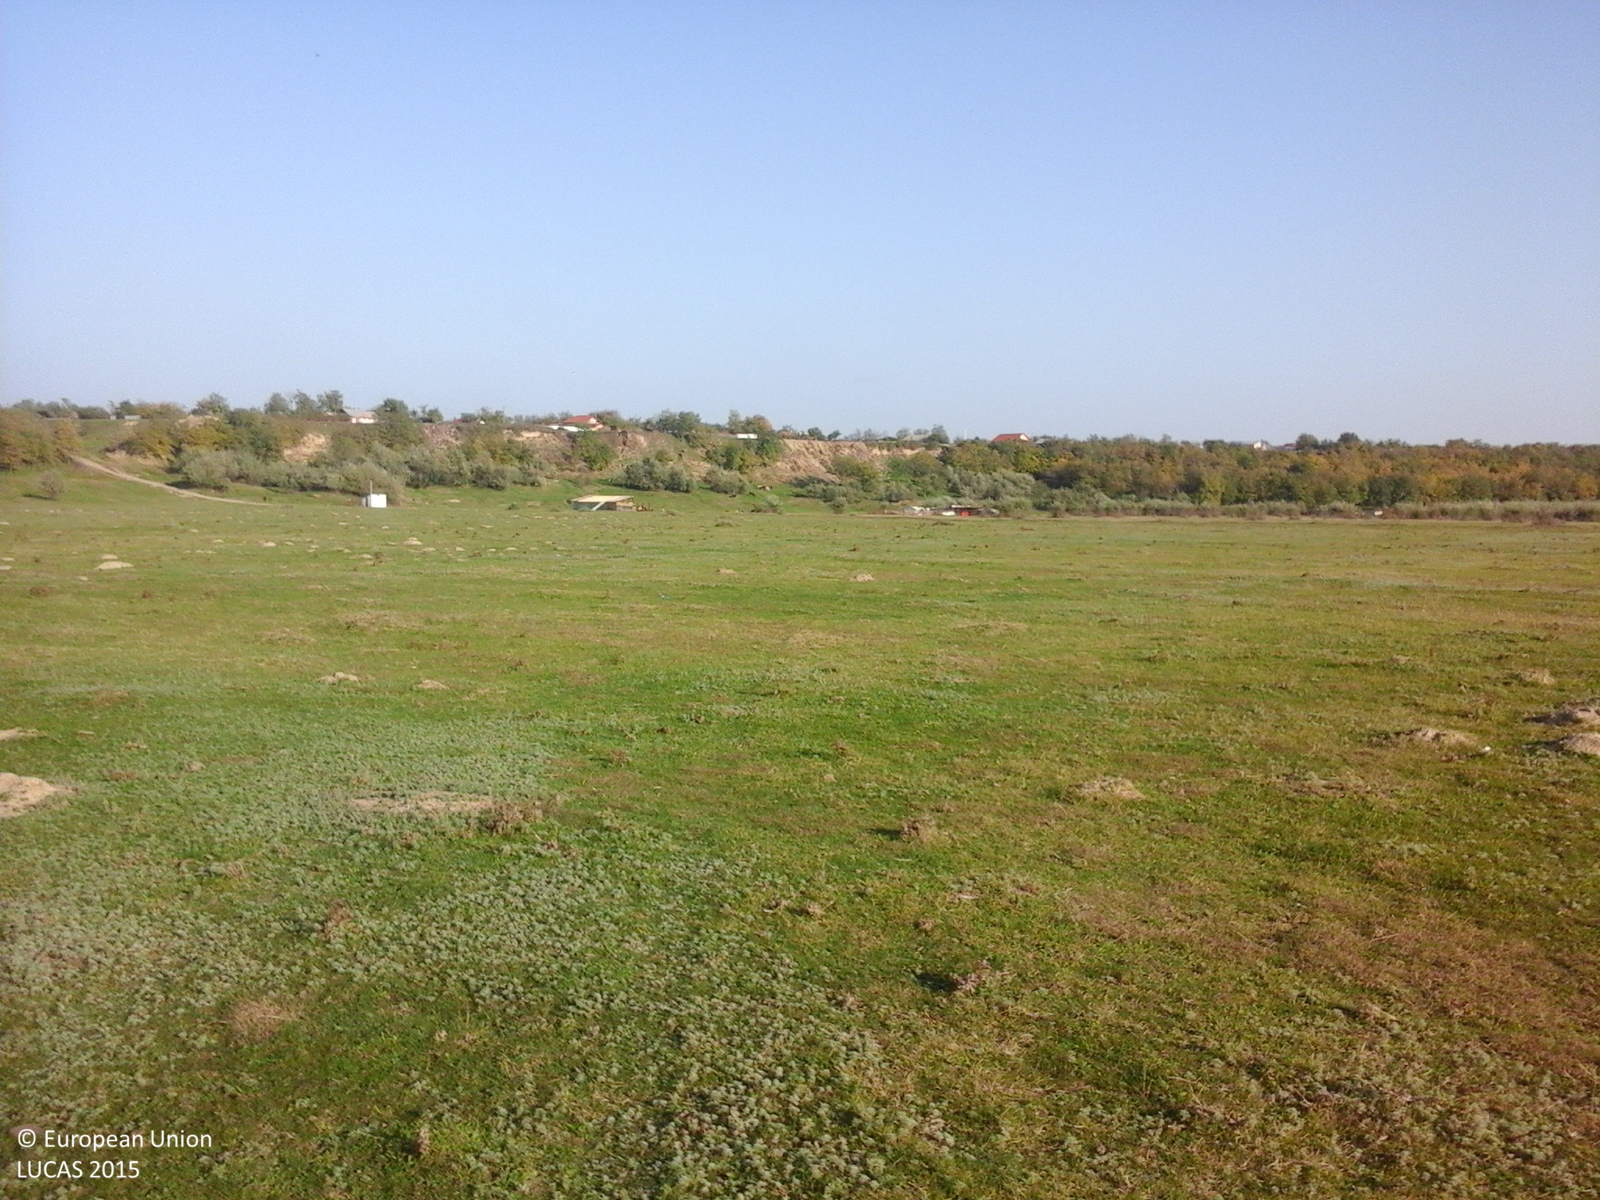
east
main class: Grassland
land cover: Grassland without tree/shrub cover
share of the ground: > 75 %
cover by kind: herbaceous plants 100 %
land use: Agriculture (excluding fallow land and kitchen gardens)
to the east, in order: Grassland without tree/shrub cover; Tracks; Grassland without tree/shrub cover
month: October
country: RO
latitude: 45.1656
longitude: 26.8622
